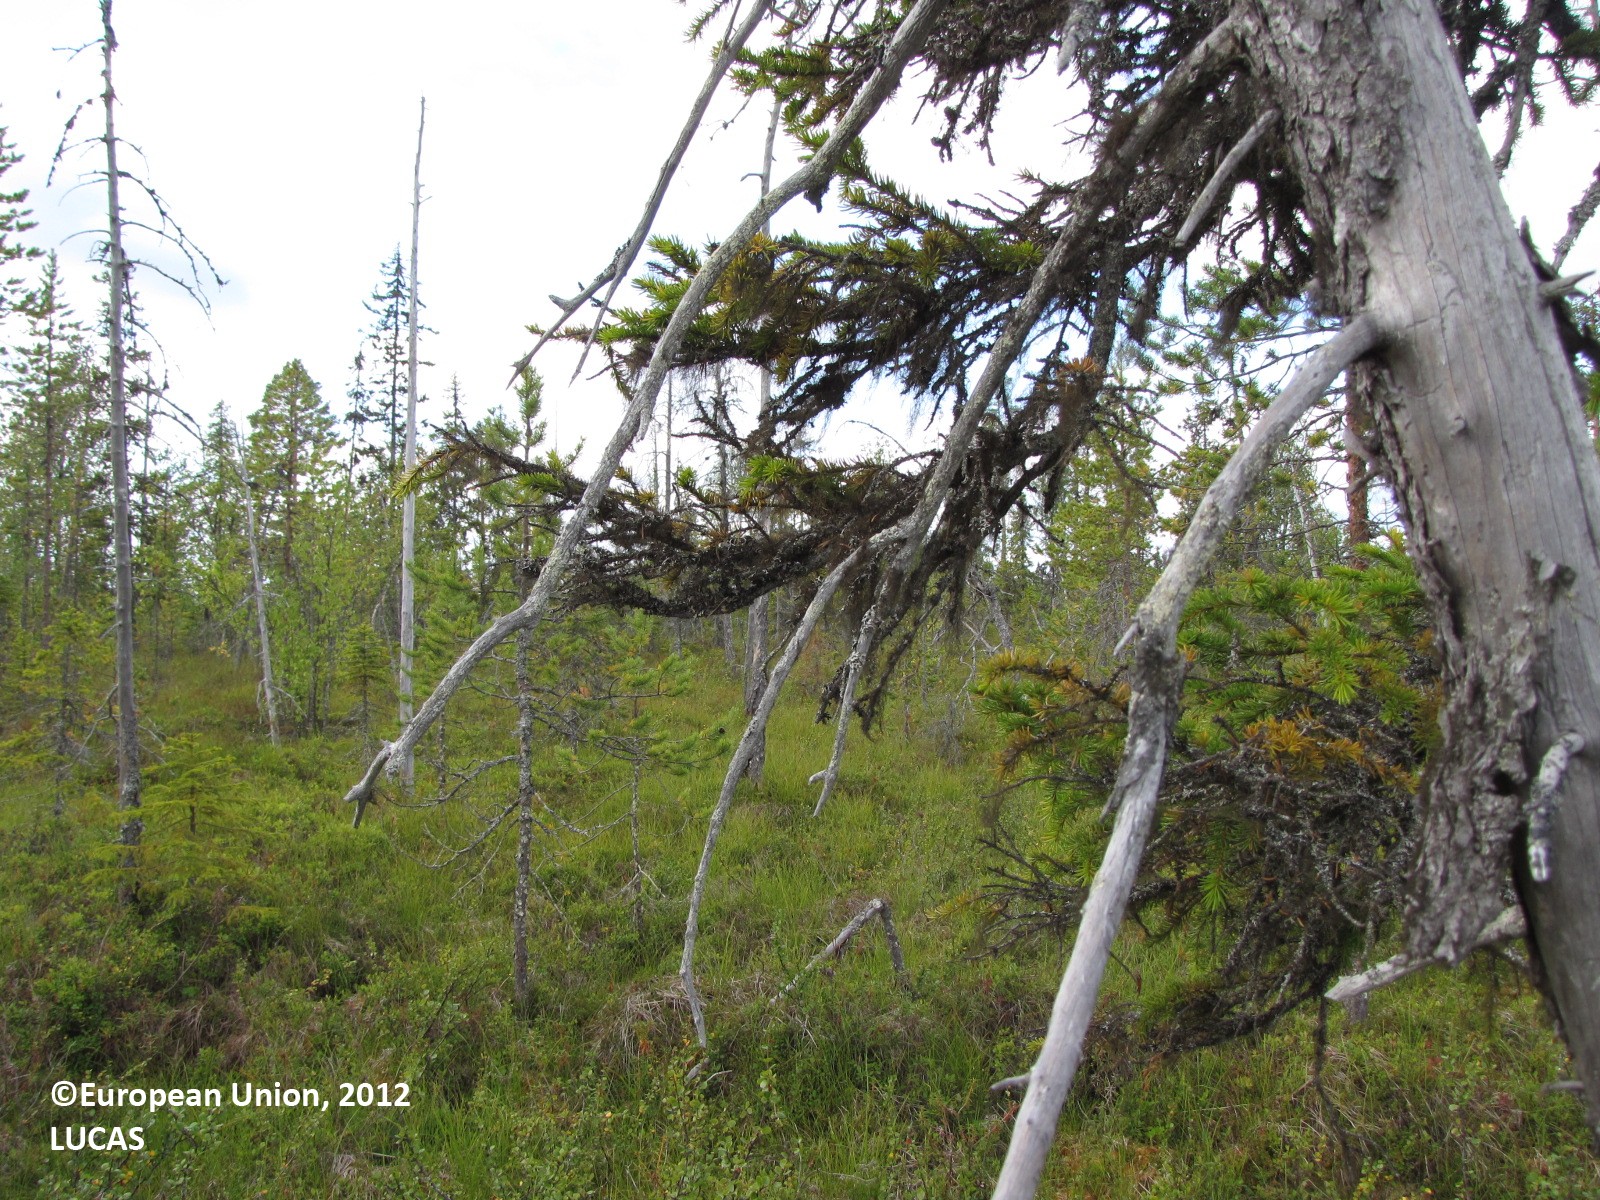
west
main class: Woodland
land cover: Pine dominated coniferous woodland
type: mire and swamp forests
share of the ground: 10 - 25 %
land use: Forestry
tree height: > 5 m
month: August
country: FI
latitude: 66.9134
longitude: 25.0173
